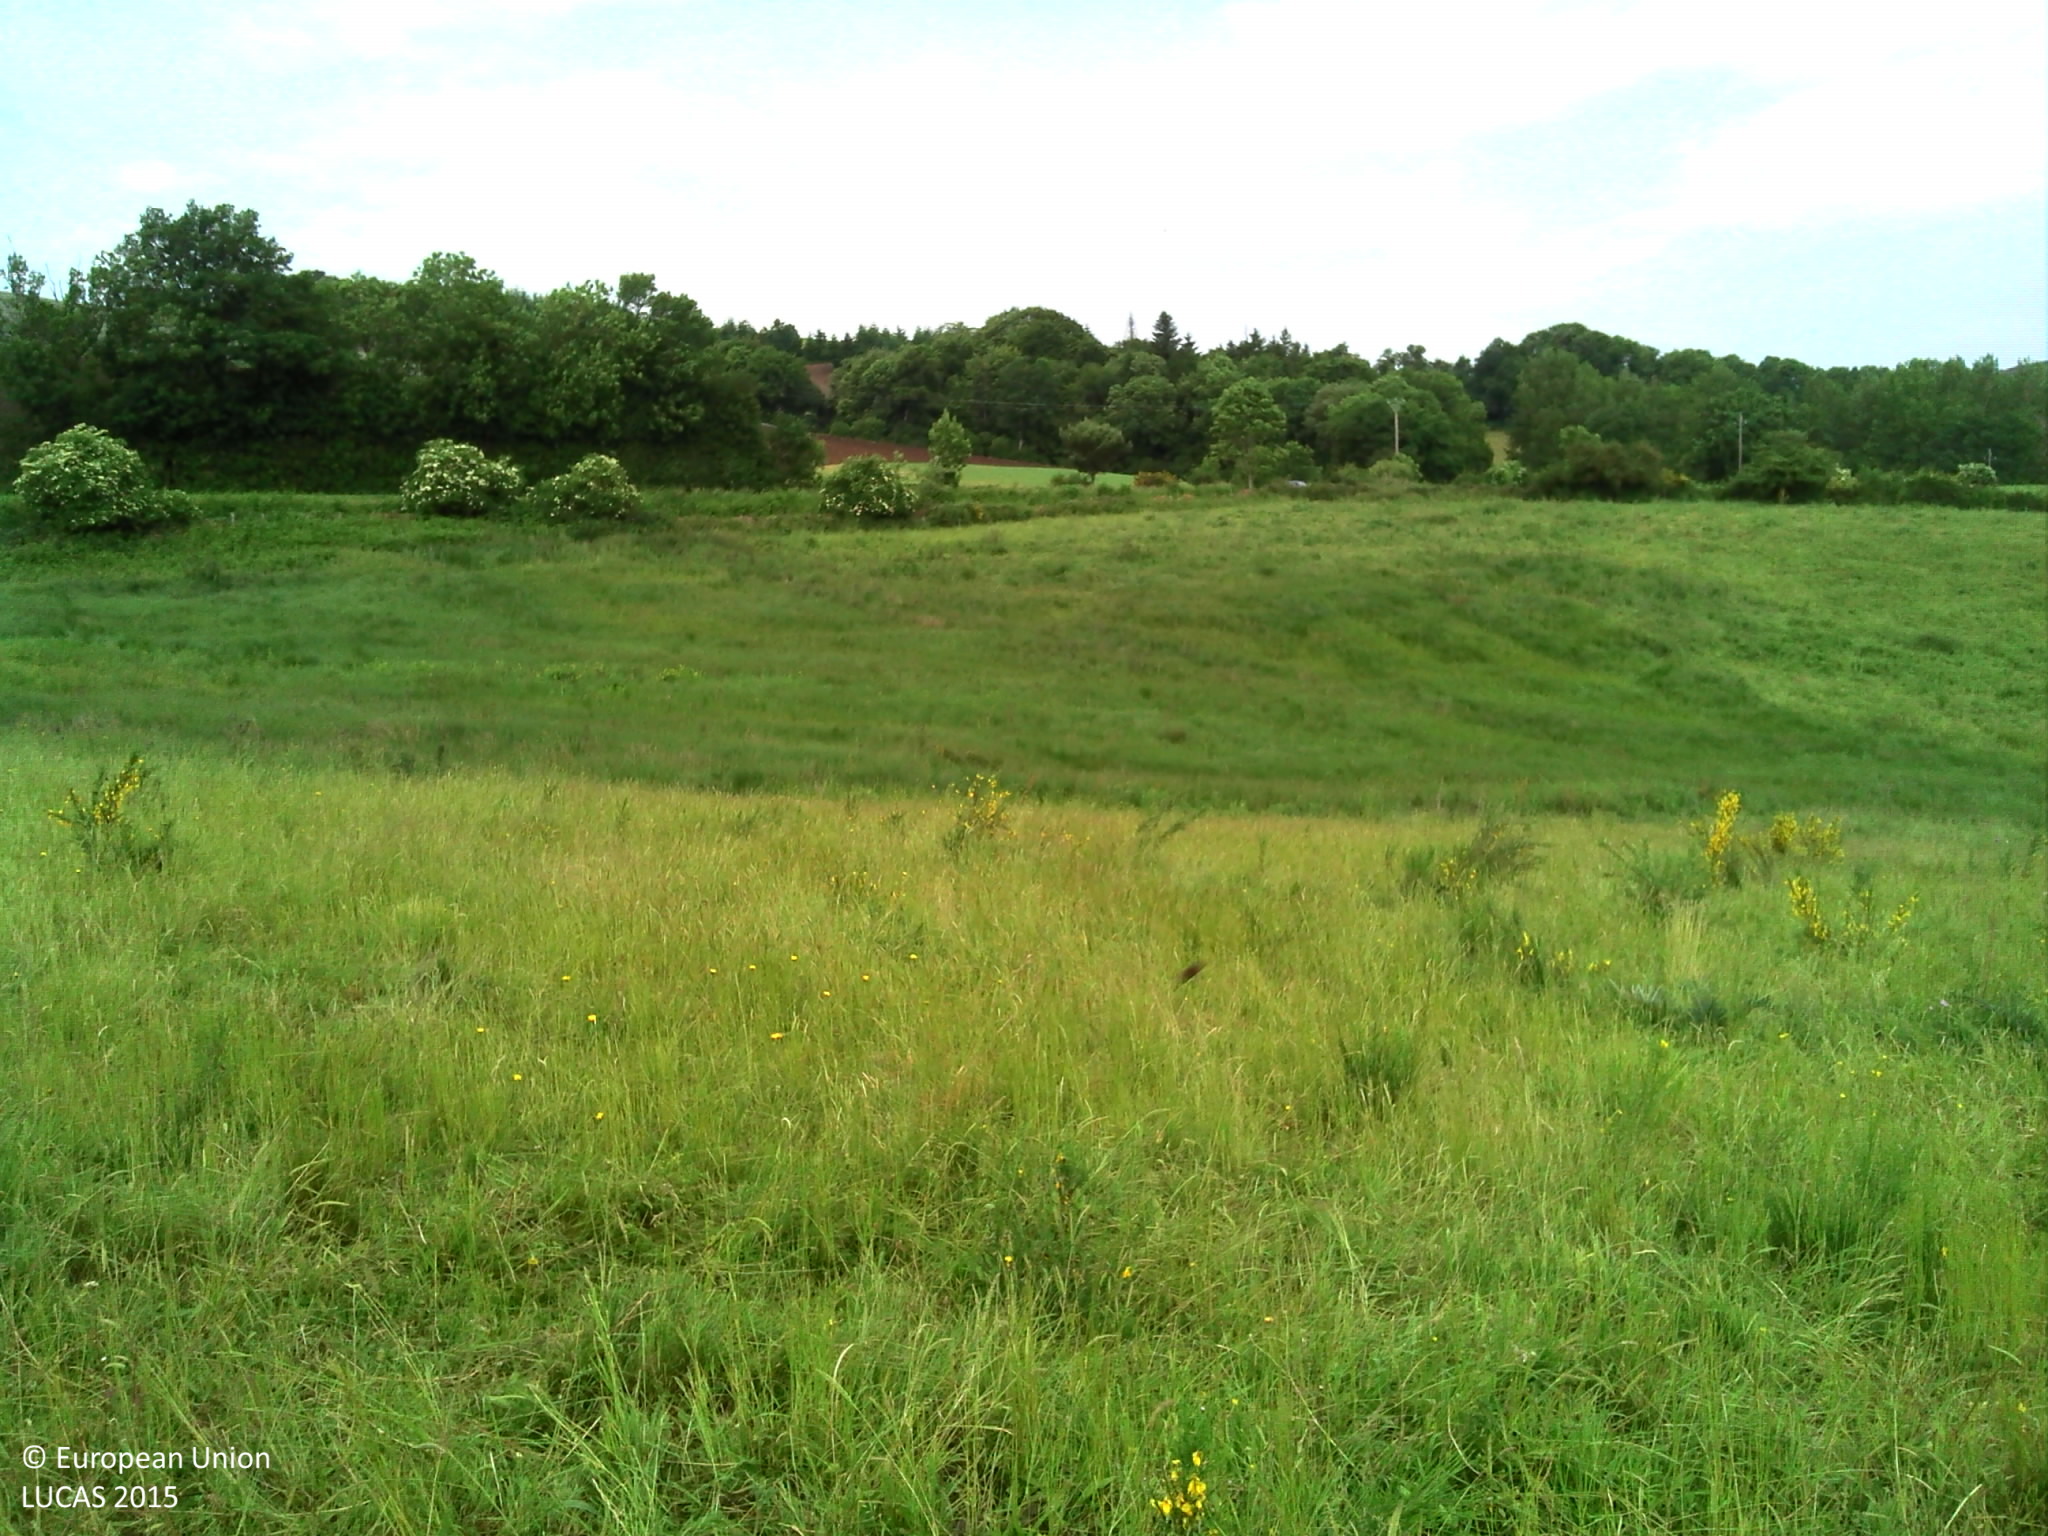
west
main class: Grassland
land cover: Grassland without tree/shrub cover
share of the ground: > 75 %
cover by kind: herbaceous plants 95 %, shrubs 5 %
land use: Agriculture (excluding fallow land and kitchen gardens)
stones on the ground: 10 - 25 %
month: June
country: FR
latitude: 44.2574
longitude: 2.9784
